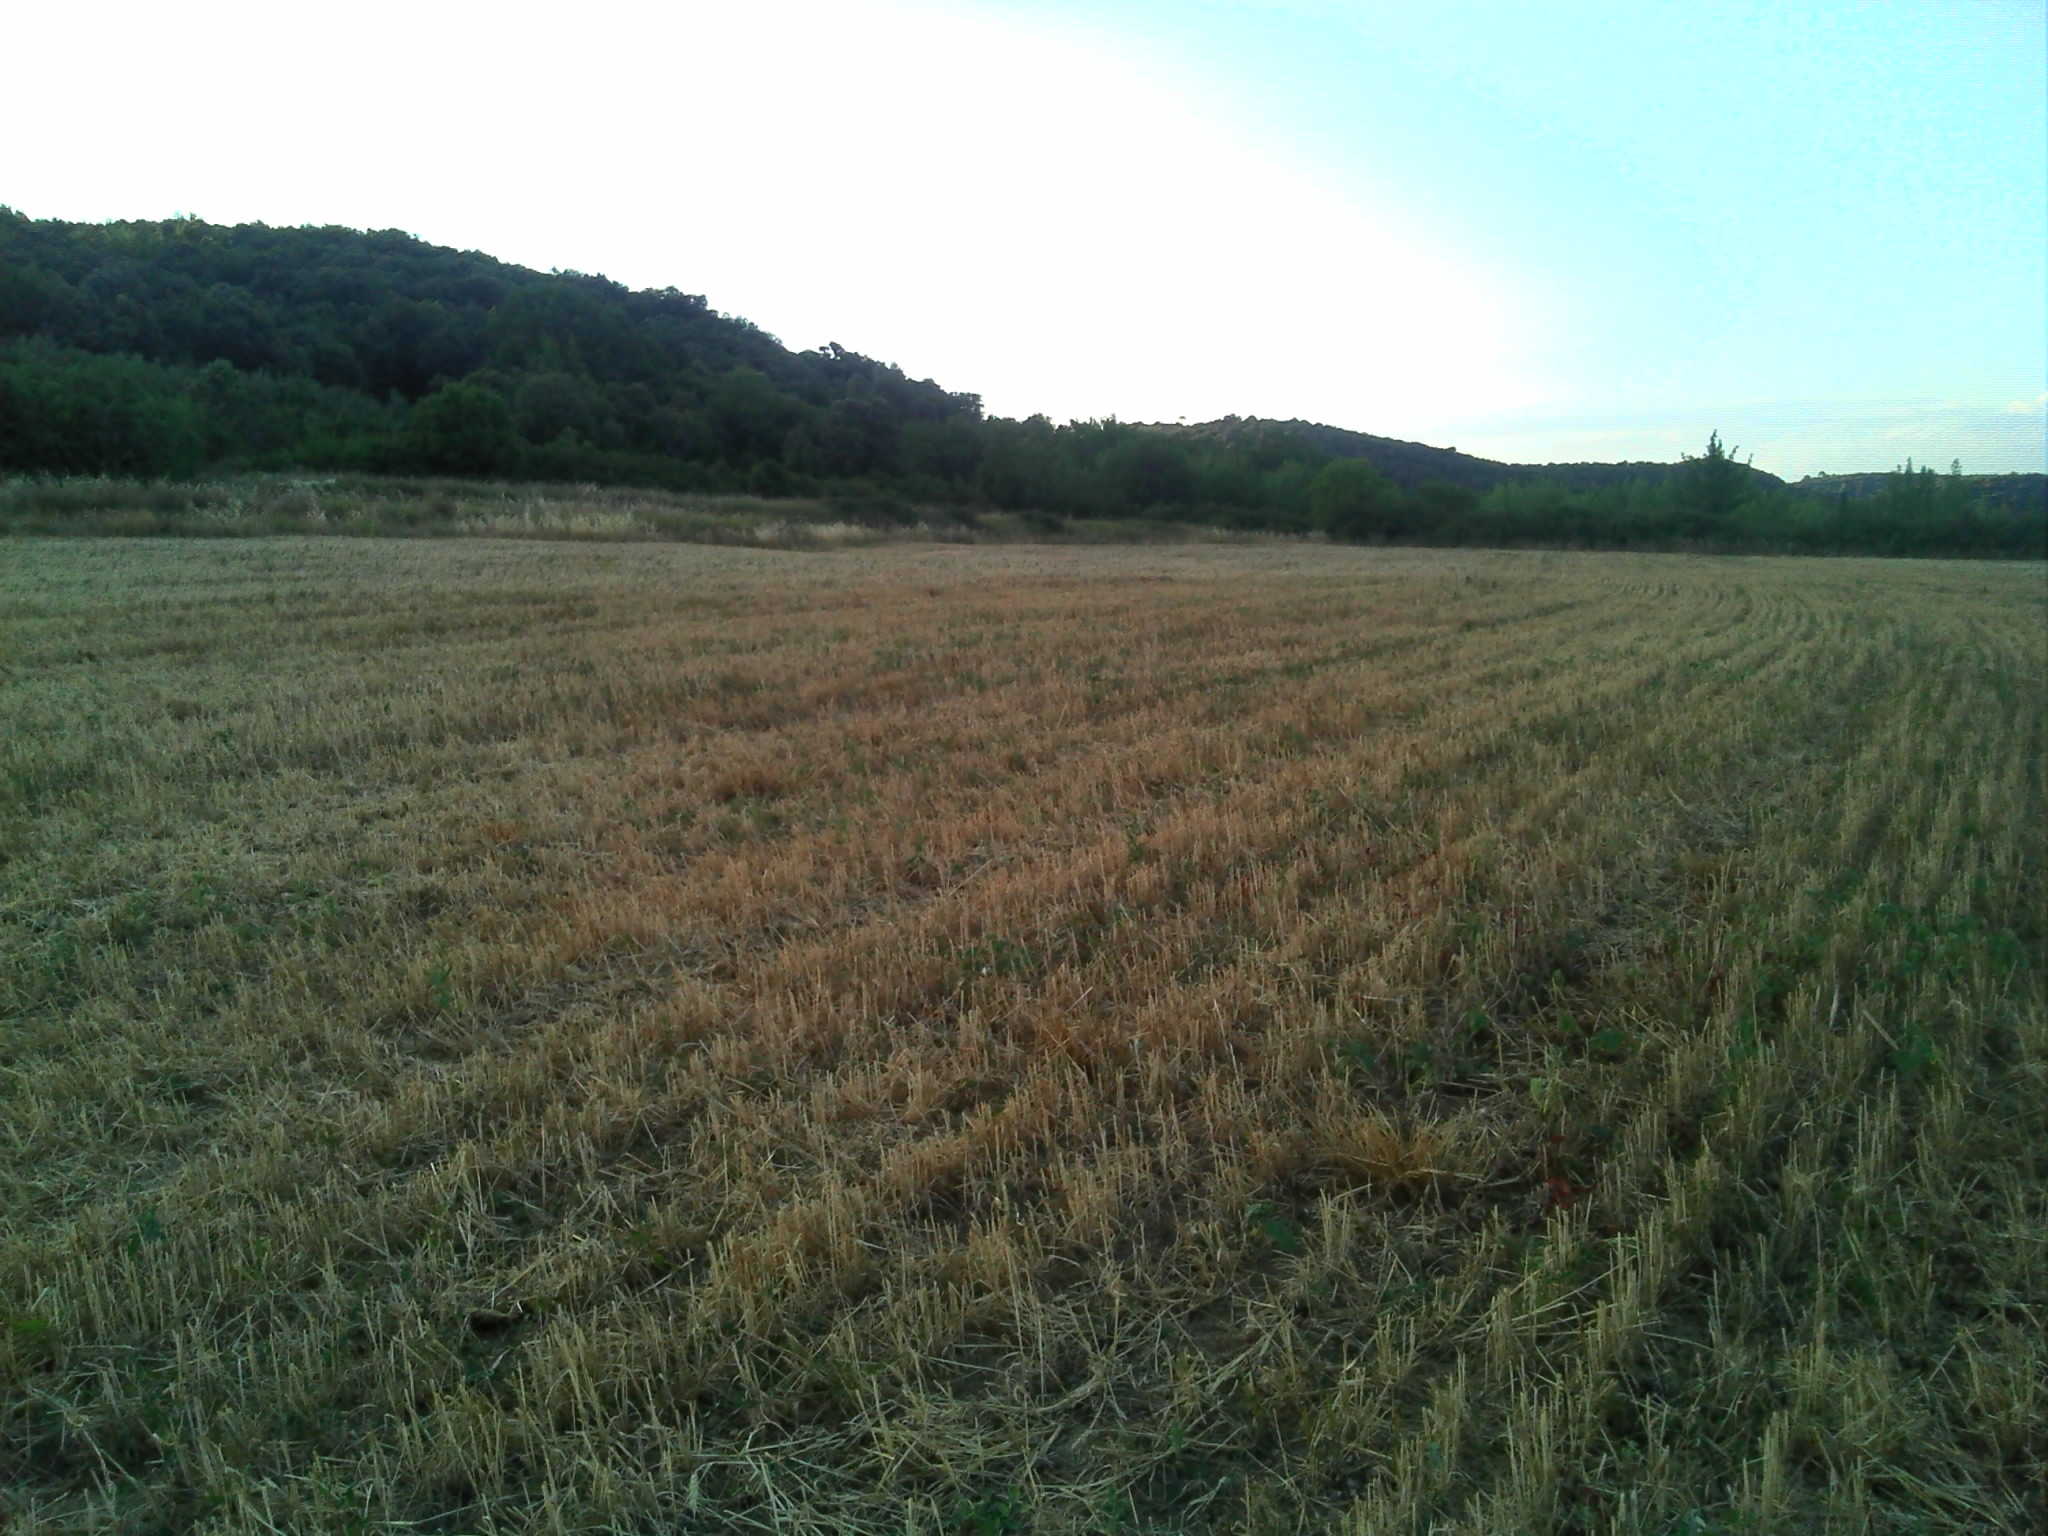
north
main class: Cropland
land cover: Common wheat
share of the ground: 10 - 25 %
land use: Agriculture (excluding fallow land and kitchen gardens)
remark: Harvested field
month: July
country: FR
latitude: 43.9938
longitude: 3.9601
